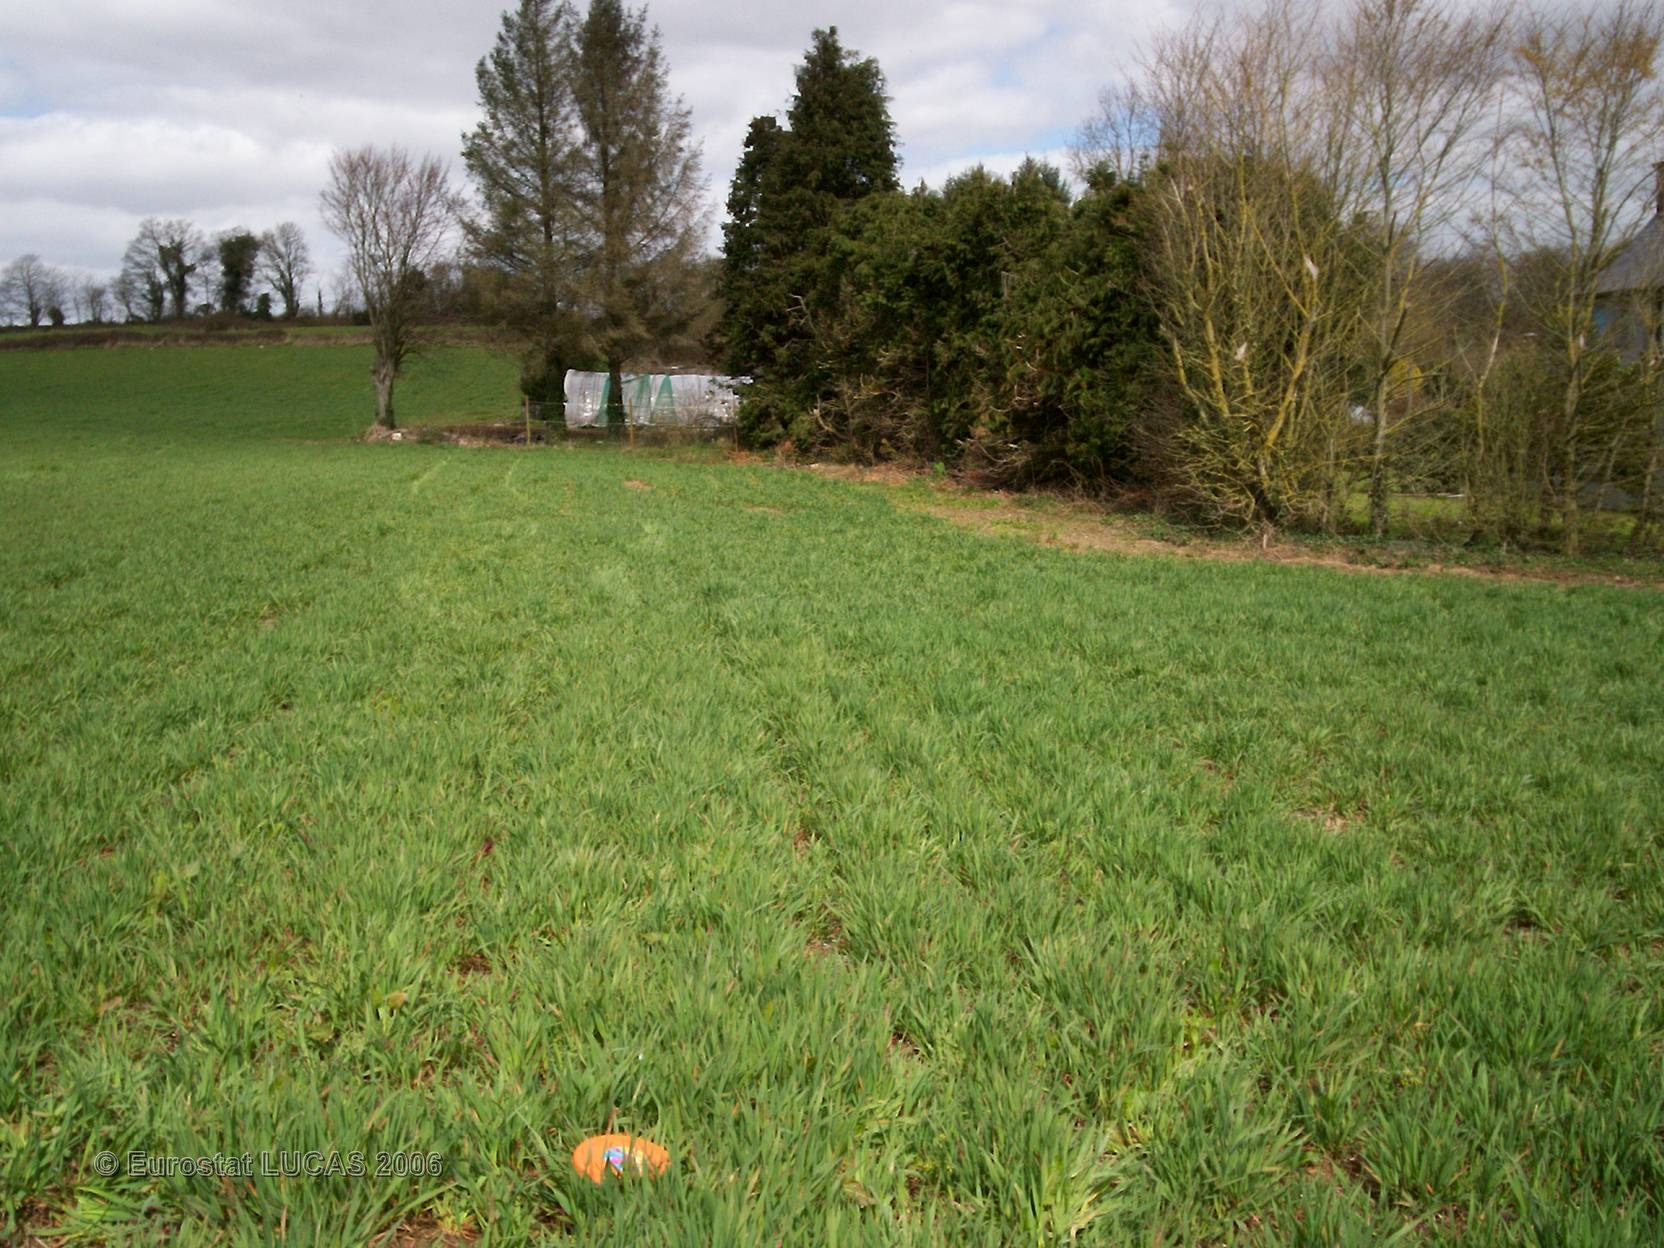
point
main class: Cropland
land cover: Oats
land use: Agriculture (excluding fallow land and kitchen gardens)
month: April
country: FR
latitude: 48.2321
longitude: -3.6101
